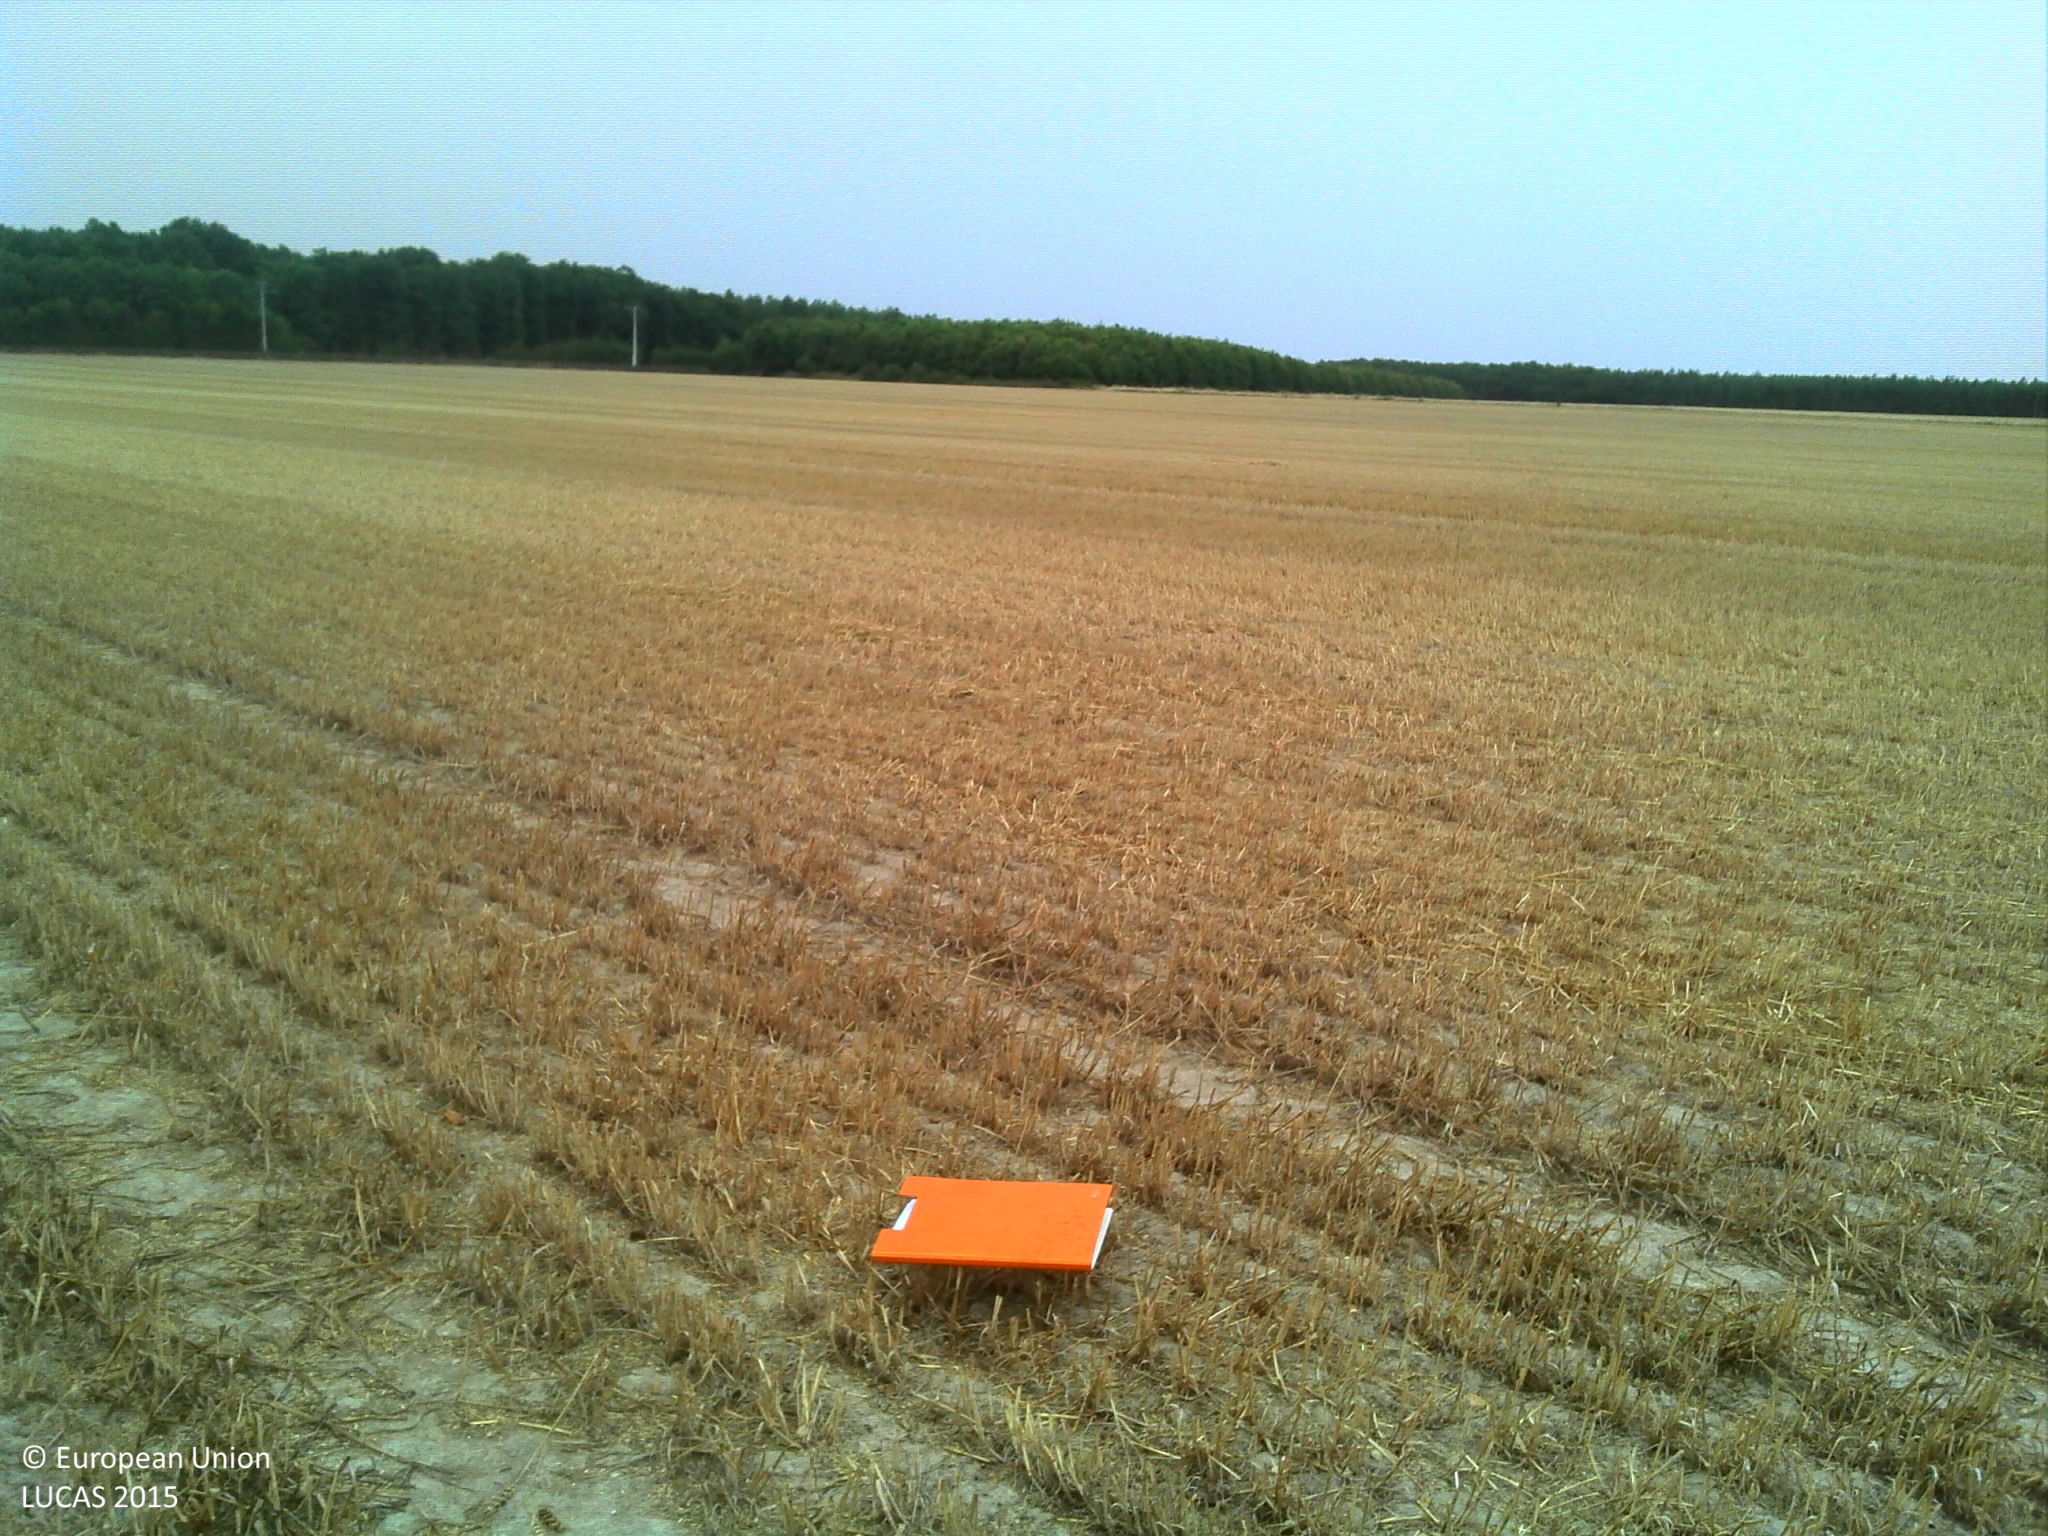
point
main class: Cropland
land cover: Common wheat
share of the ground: > 75 %
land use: Agriculture (excluding fallow land and kitchen gardens)
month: July
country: FR
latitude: 46.7858
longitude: 2.1461
